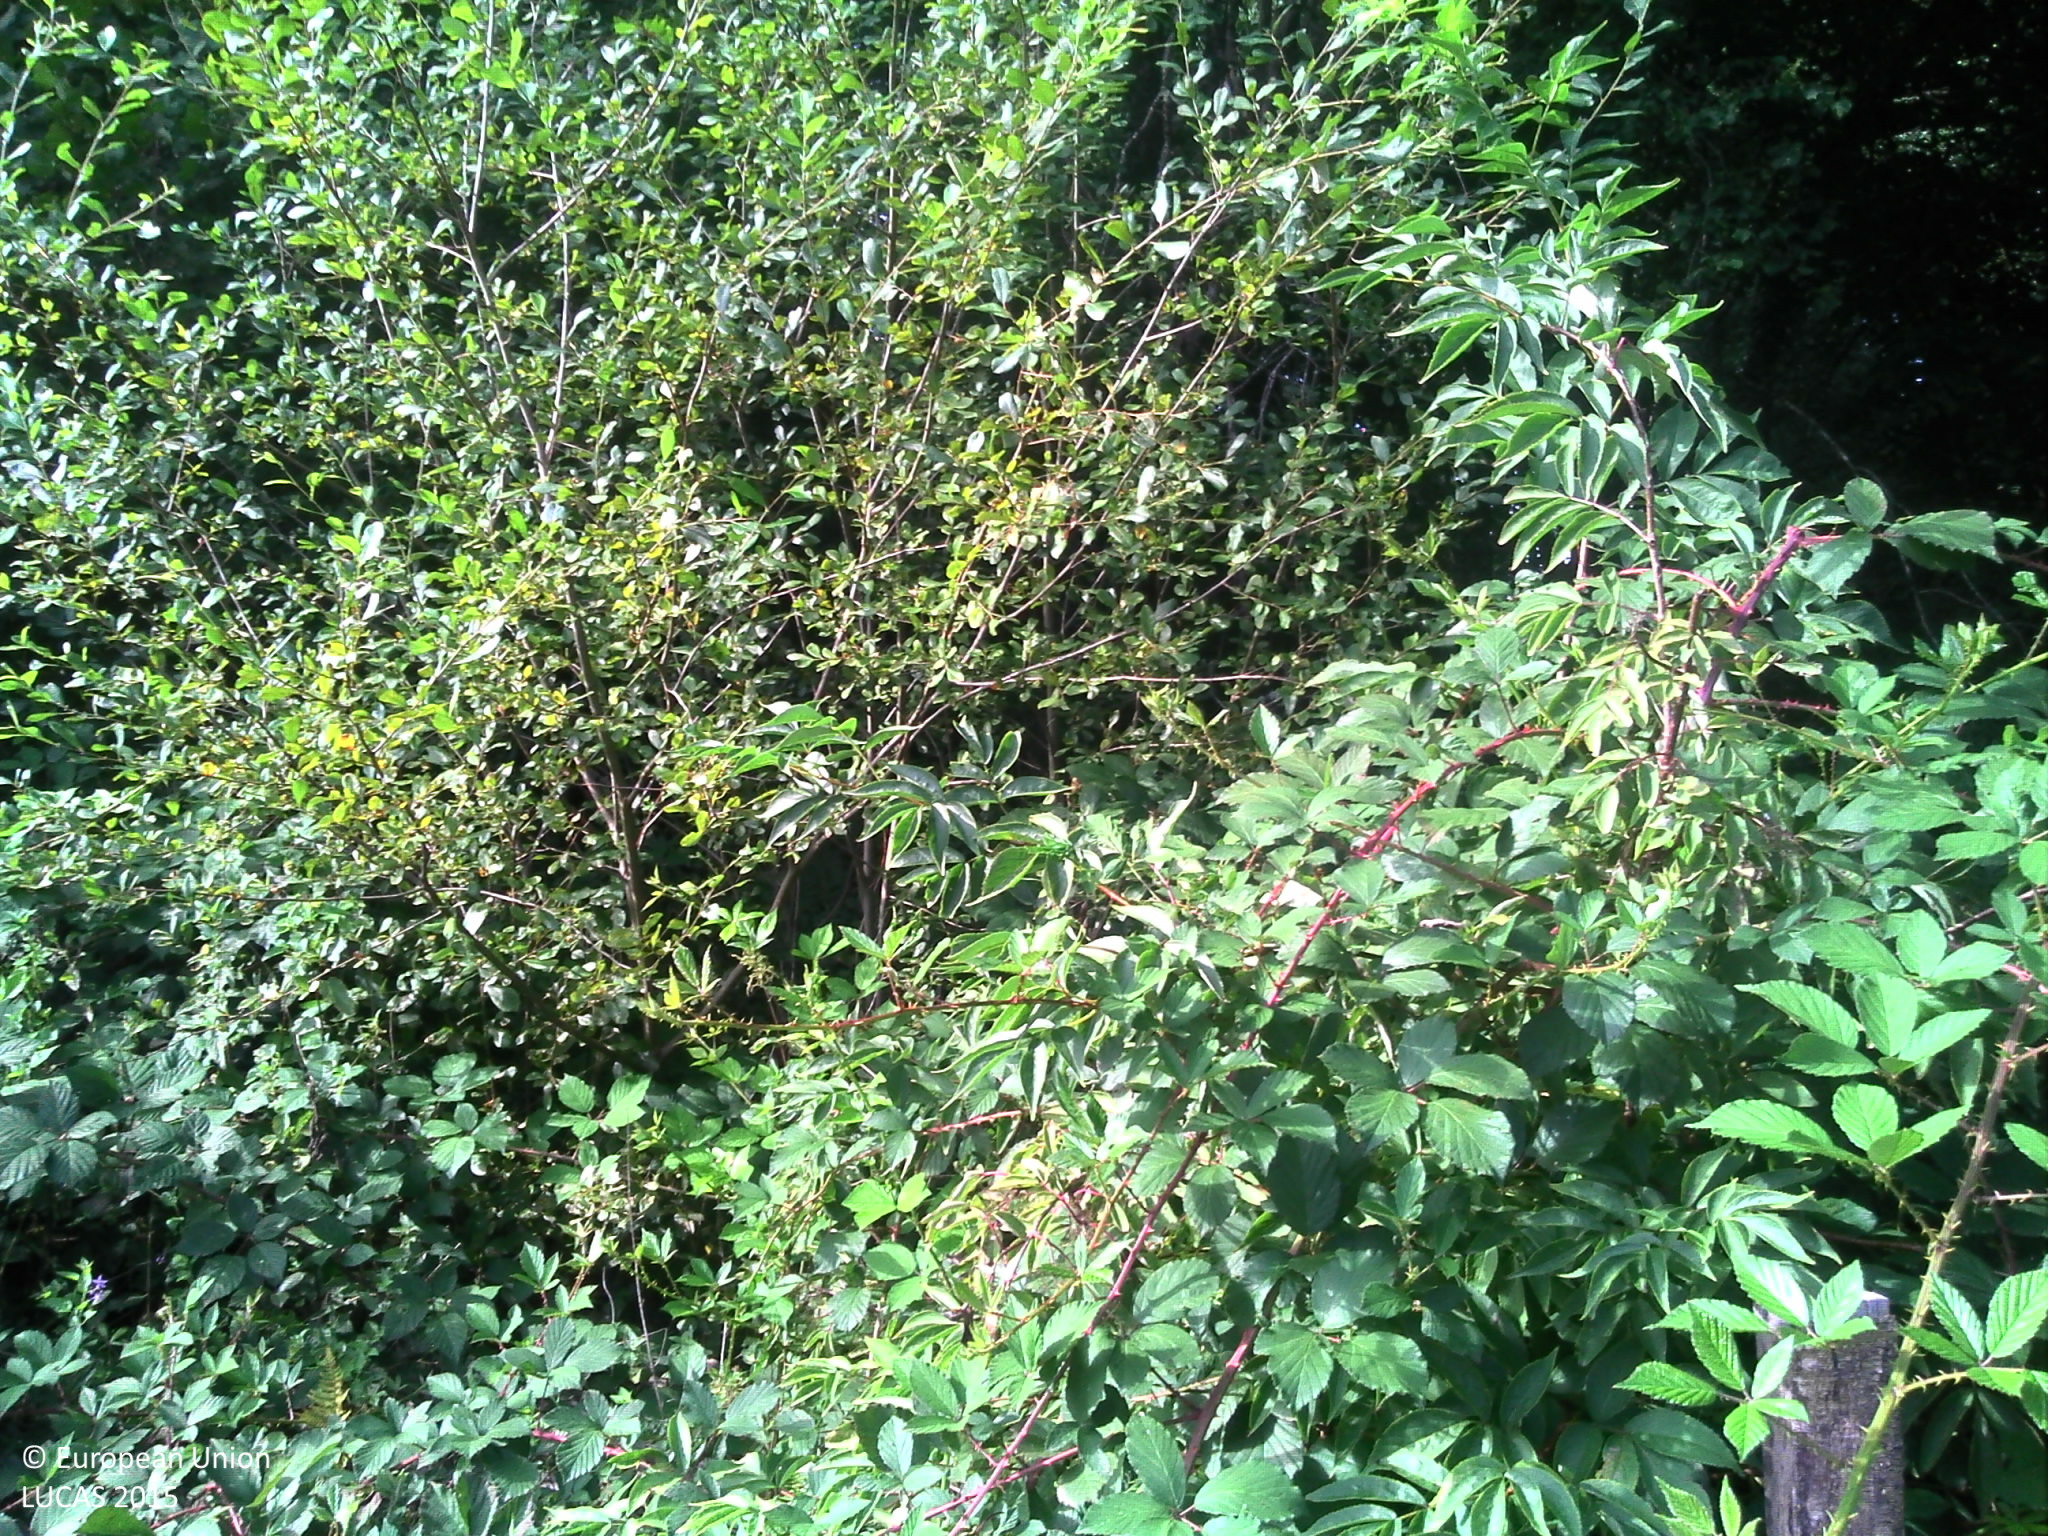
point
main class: Woodland
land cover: Broadleaved woodland
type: floodplain forest
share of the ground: > 75 %
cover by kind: broadleaved forest trees 70 %, shrubs 15 %, herbaceous plants 15 %
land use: Forestry
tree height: > 5 m
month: August
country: FR
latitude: 46.1782
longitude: 1.7666
